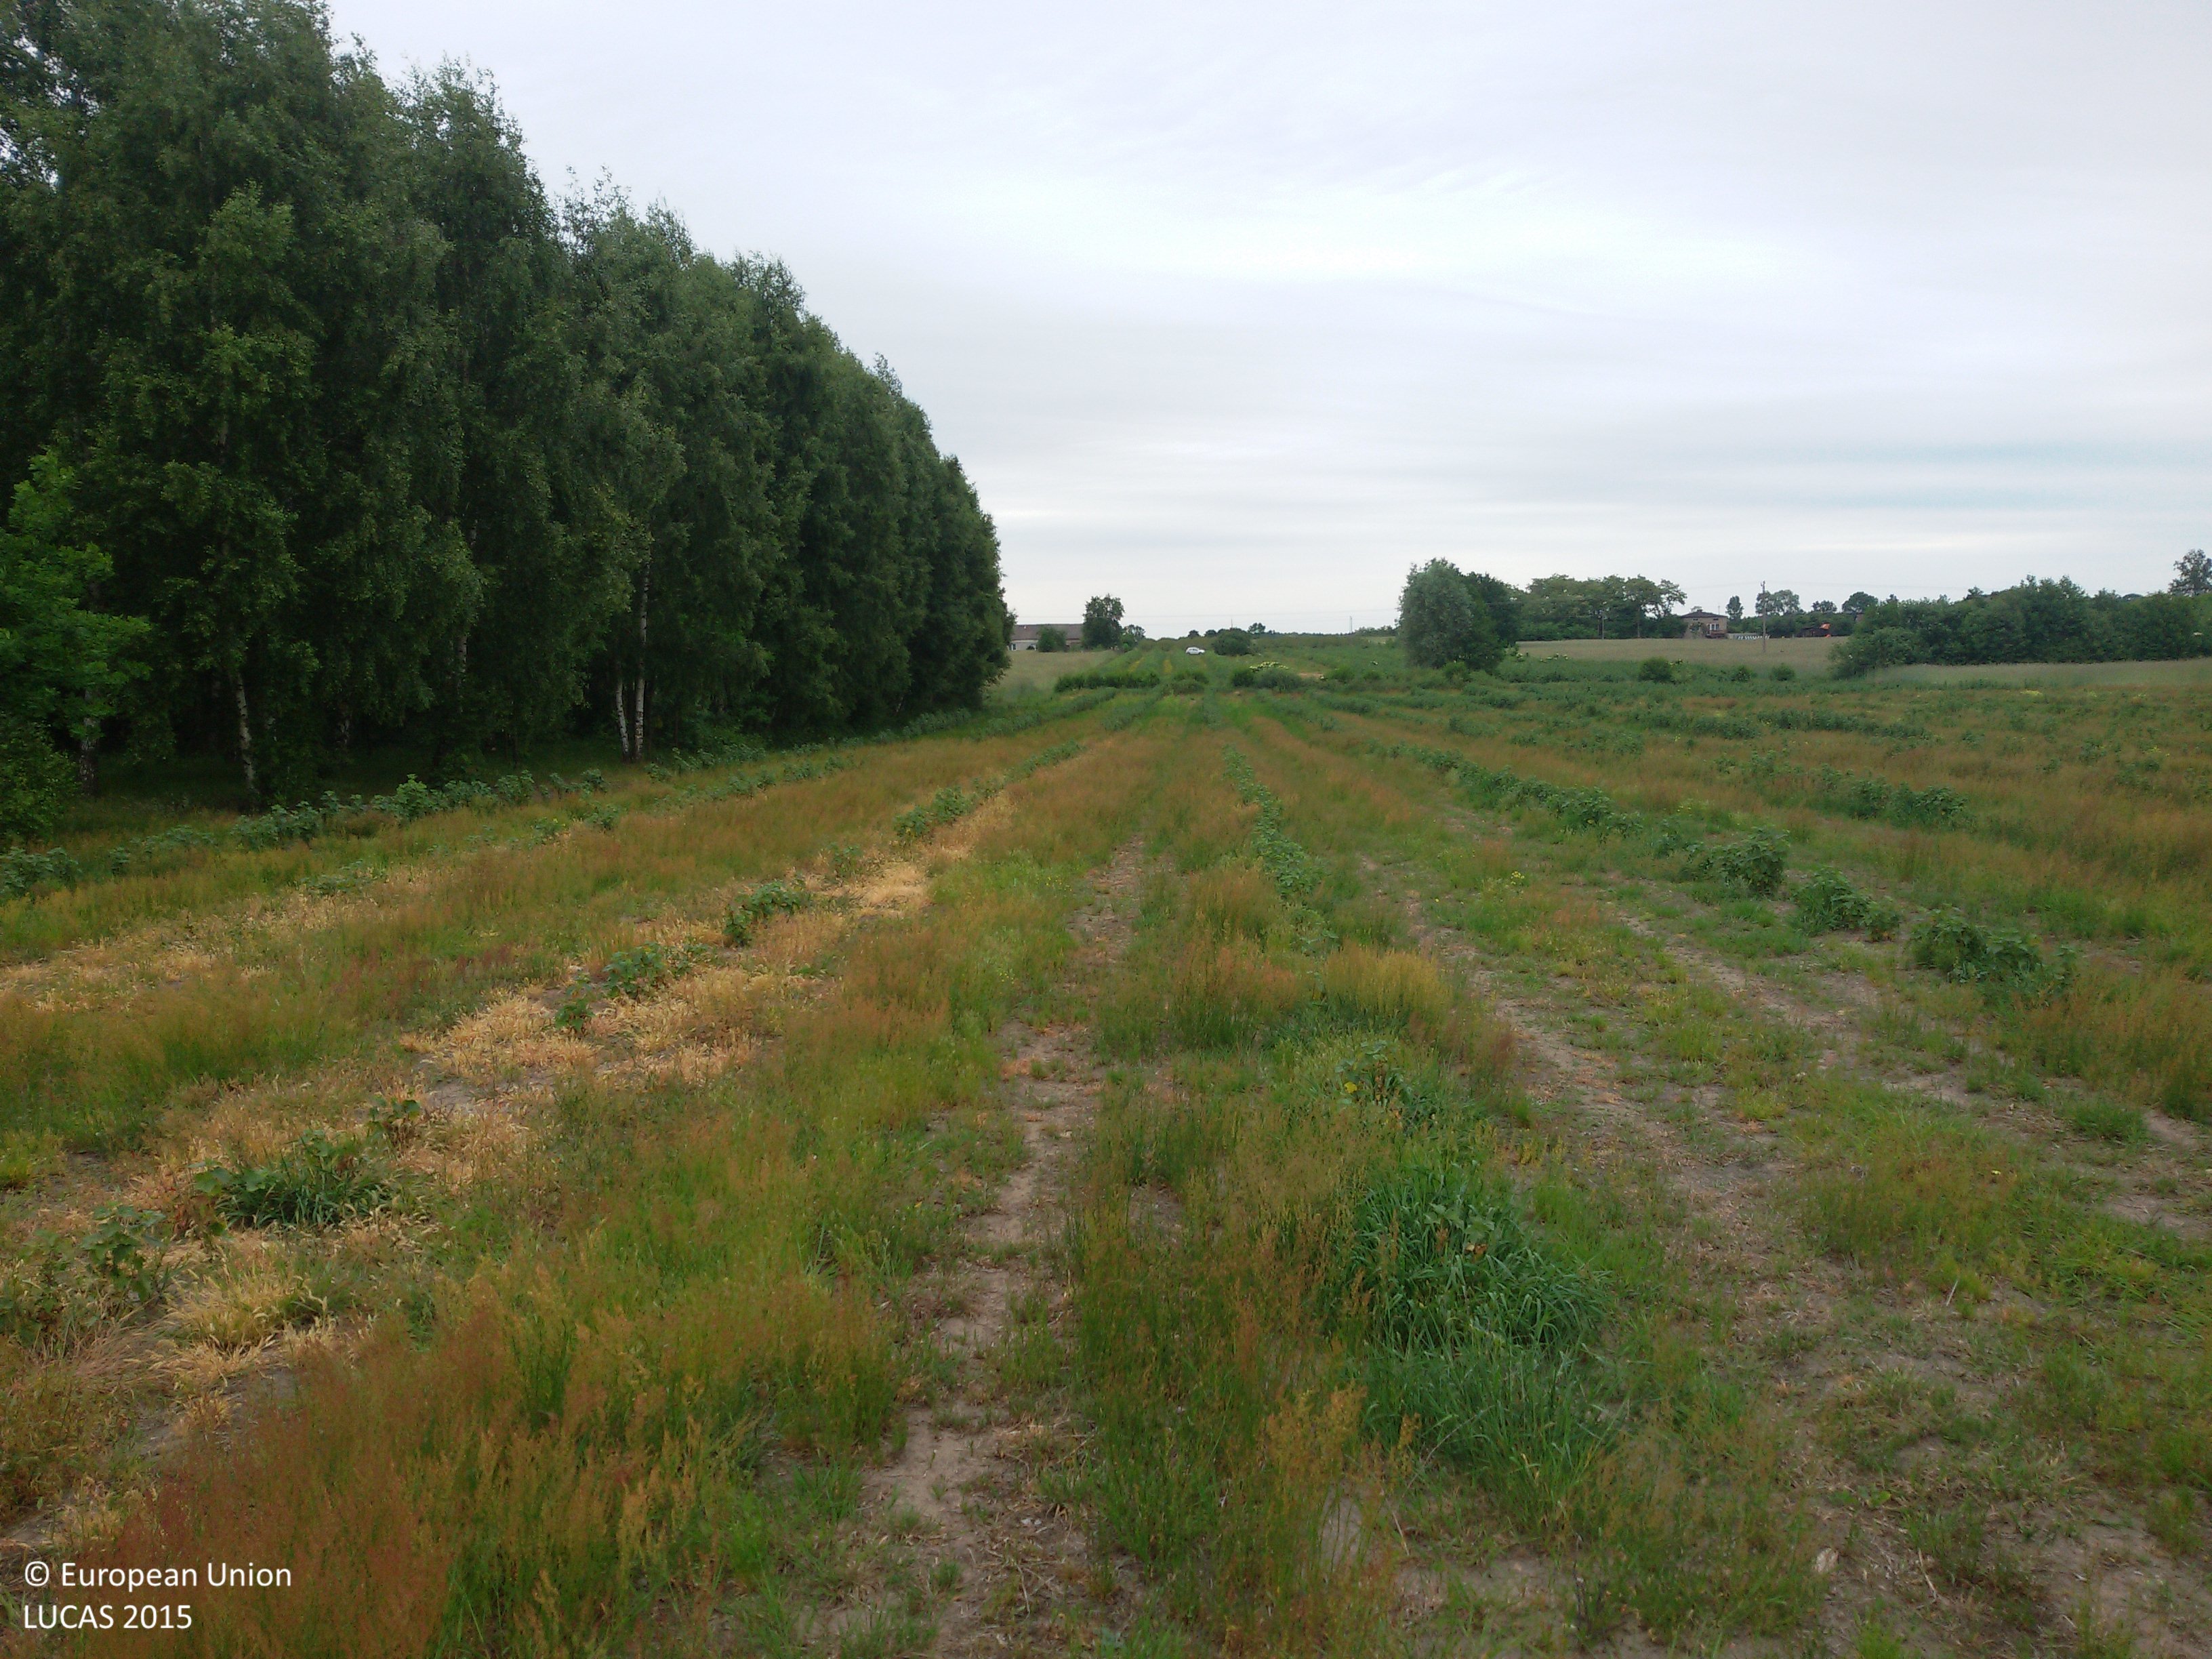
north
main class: Cropland
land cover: Other fruit trees and berries
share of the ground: 25 - 50 %
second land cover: Grassland without tree/shrub cover
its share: 50 - 75 %
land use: Agriculture (excluding fallow land and kitchen gardens)
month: June
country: PL
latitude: 51.9510
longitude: 19.8230
